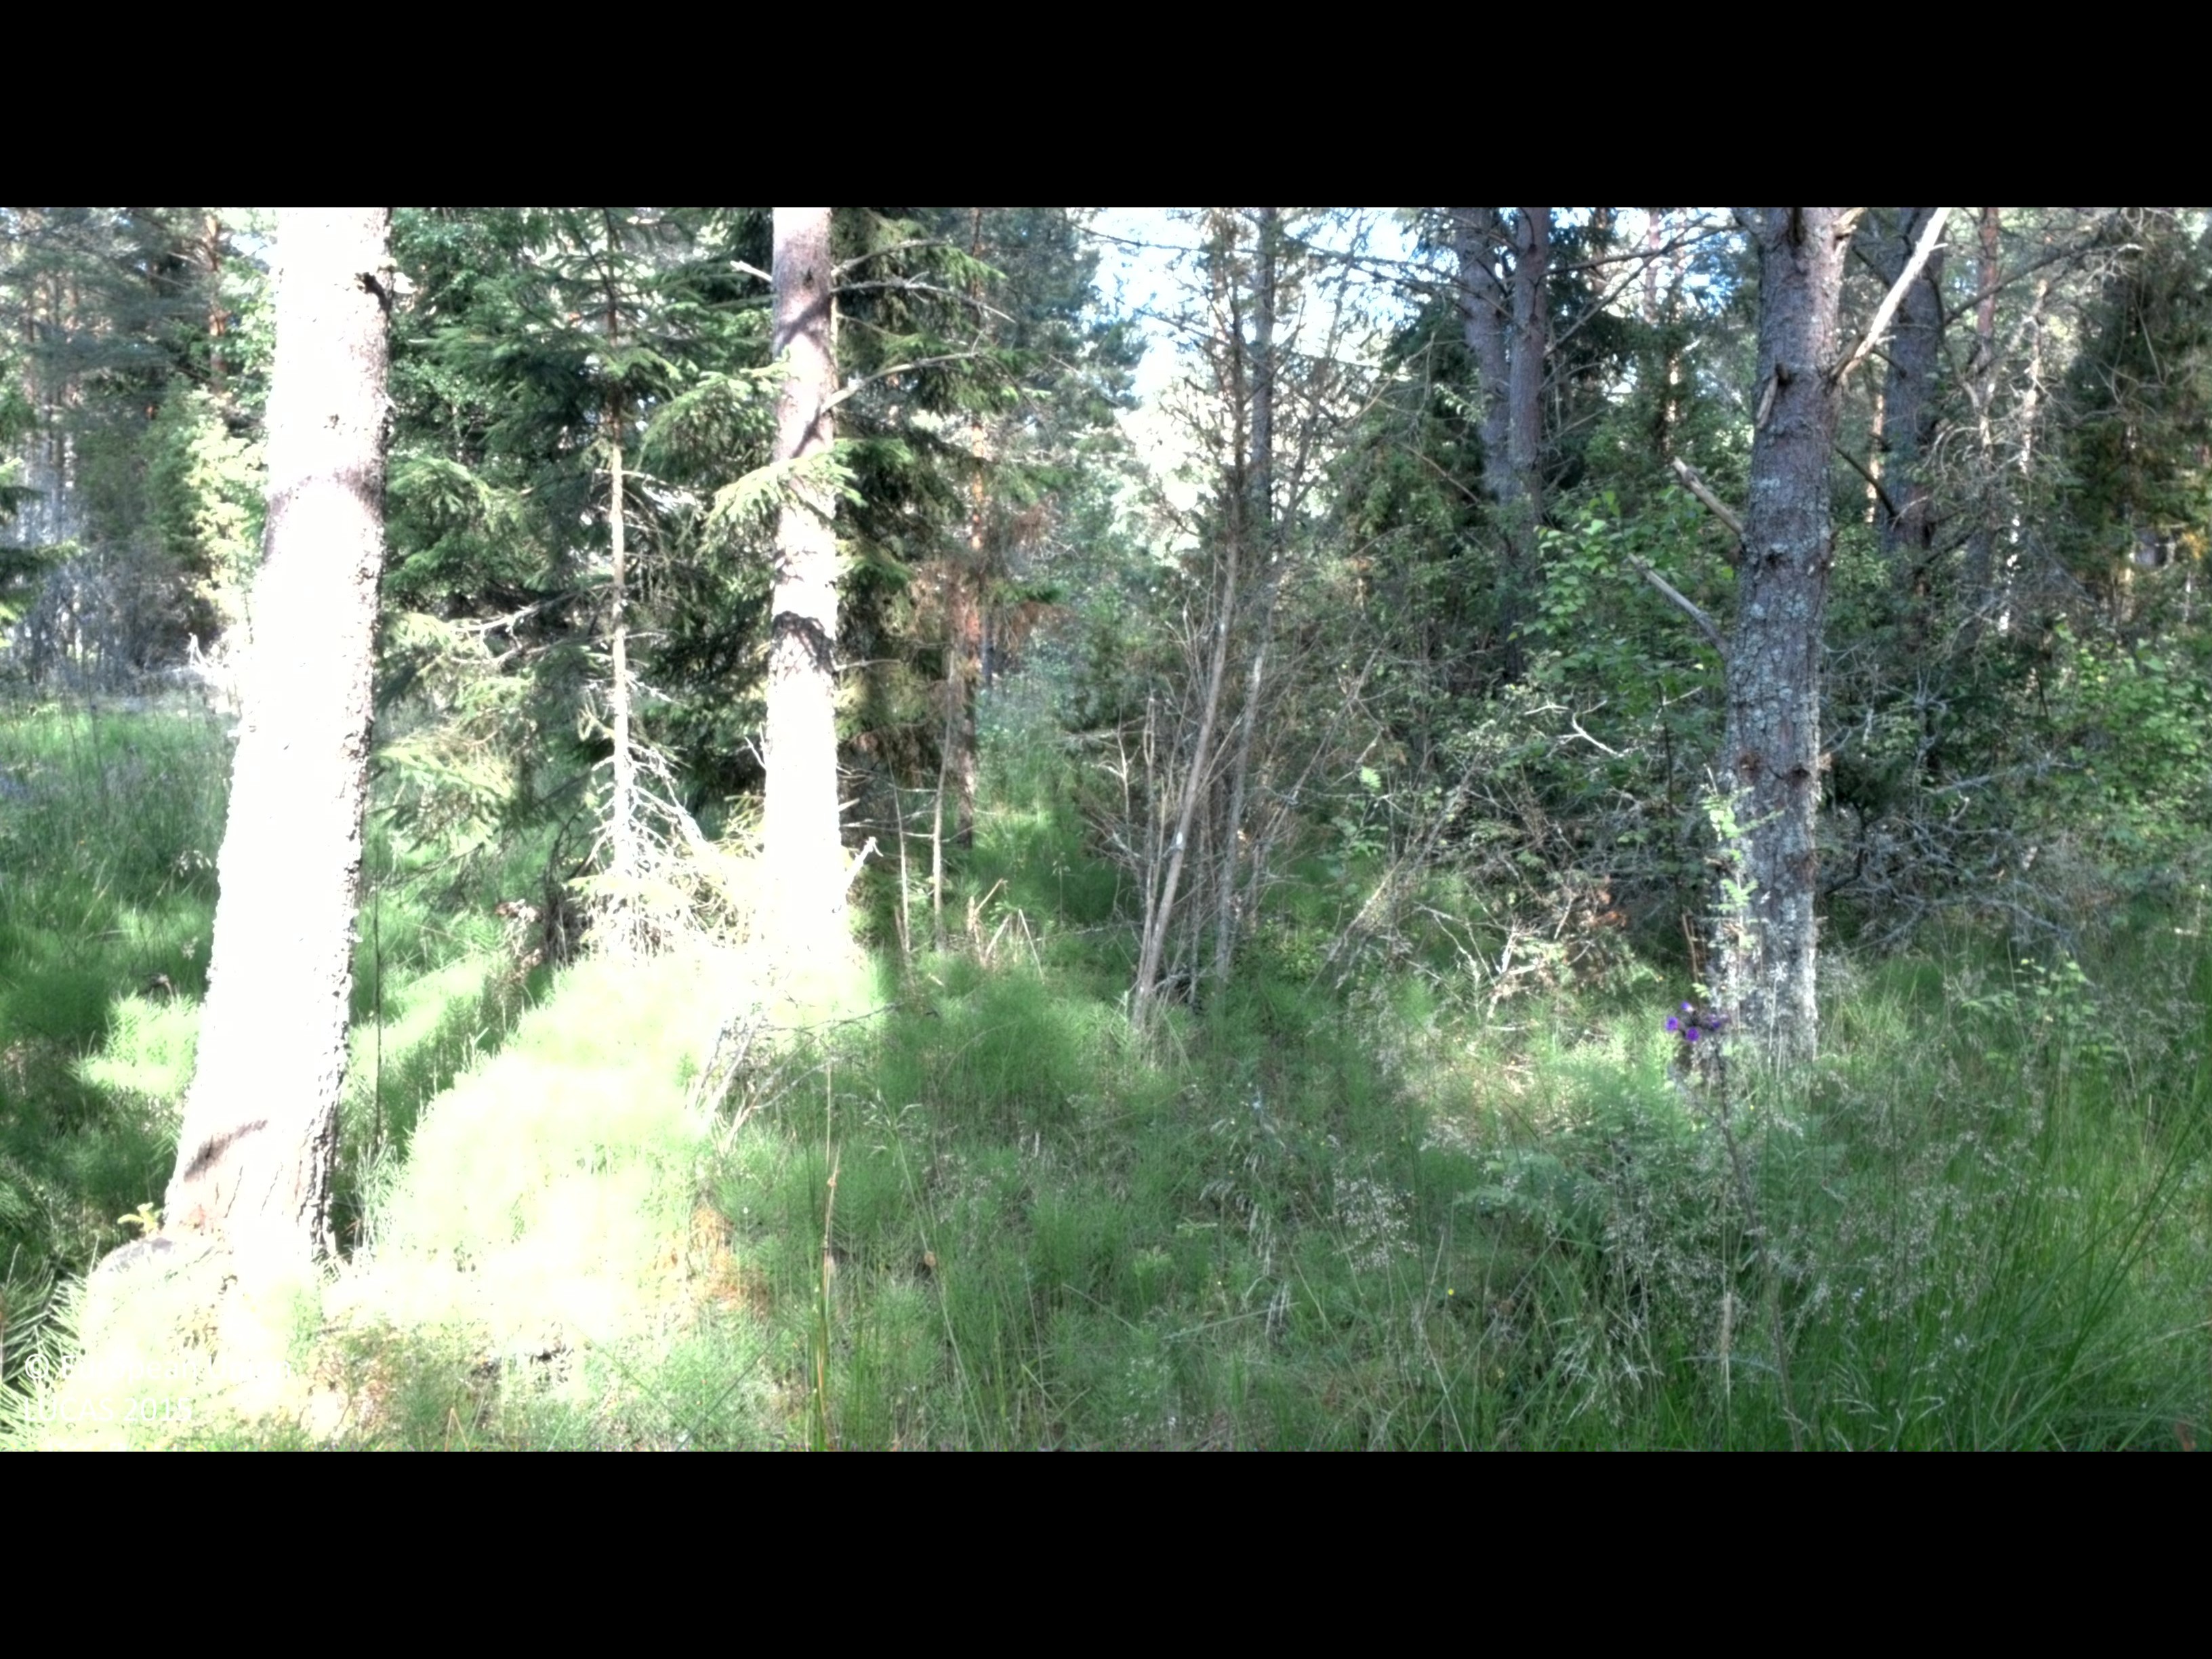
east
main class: Woodland
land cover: Pine dominated coniferous woodland
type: boreal forest
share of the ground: 50 - 75 %
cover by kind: coniferous forest trees 65 %, shrubs 20 %, herbaceous plants 10 %, broadleaved forest trees 5 %
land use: Forestry
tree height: > 5 m
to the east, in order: Pine dominated coniferous woodland; Ditches and canals; Grassland with sparse tree/shrub cover; Grassland without tree/shrub cover; Ditches and canals; Grassland without tree/shrub cover; Broadleaved woodland; Ditches and canals; Fences; Broadleaved woodland; Fences; Pine dominated coniferous woodland
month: July
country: SE
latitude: 58.3962
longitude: 16.6865
